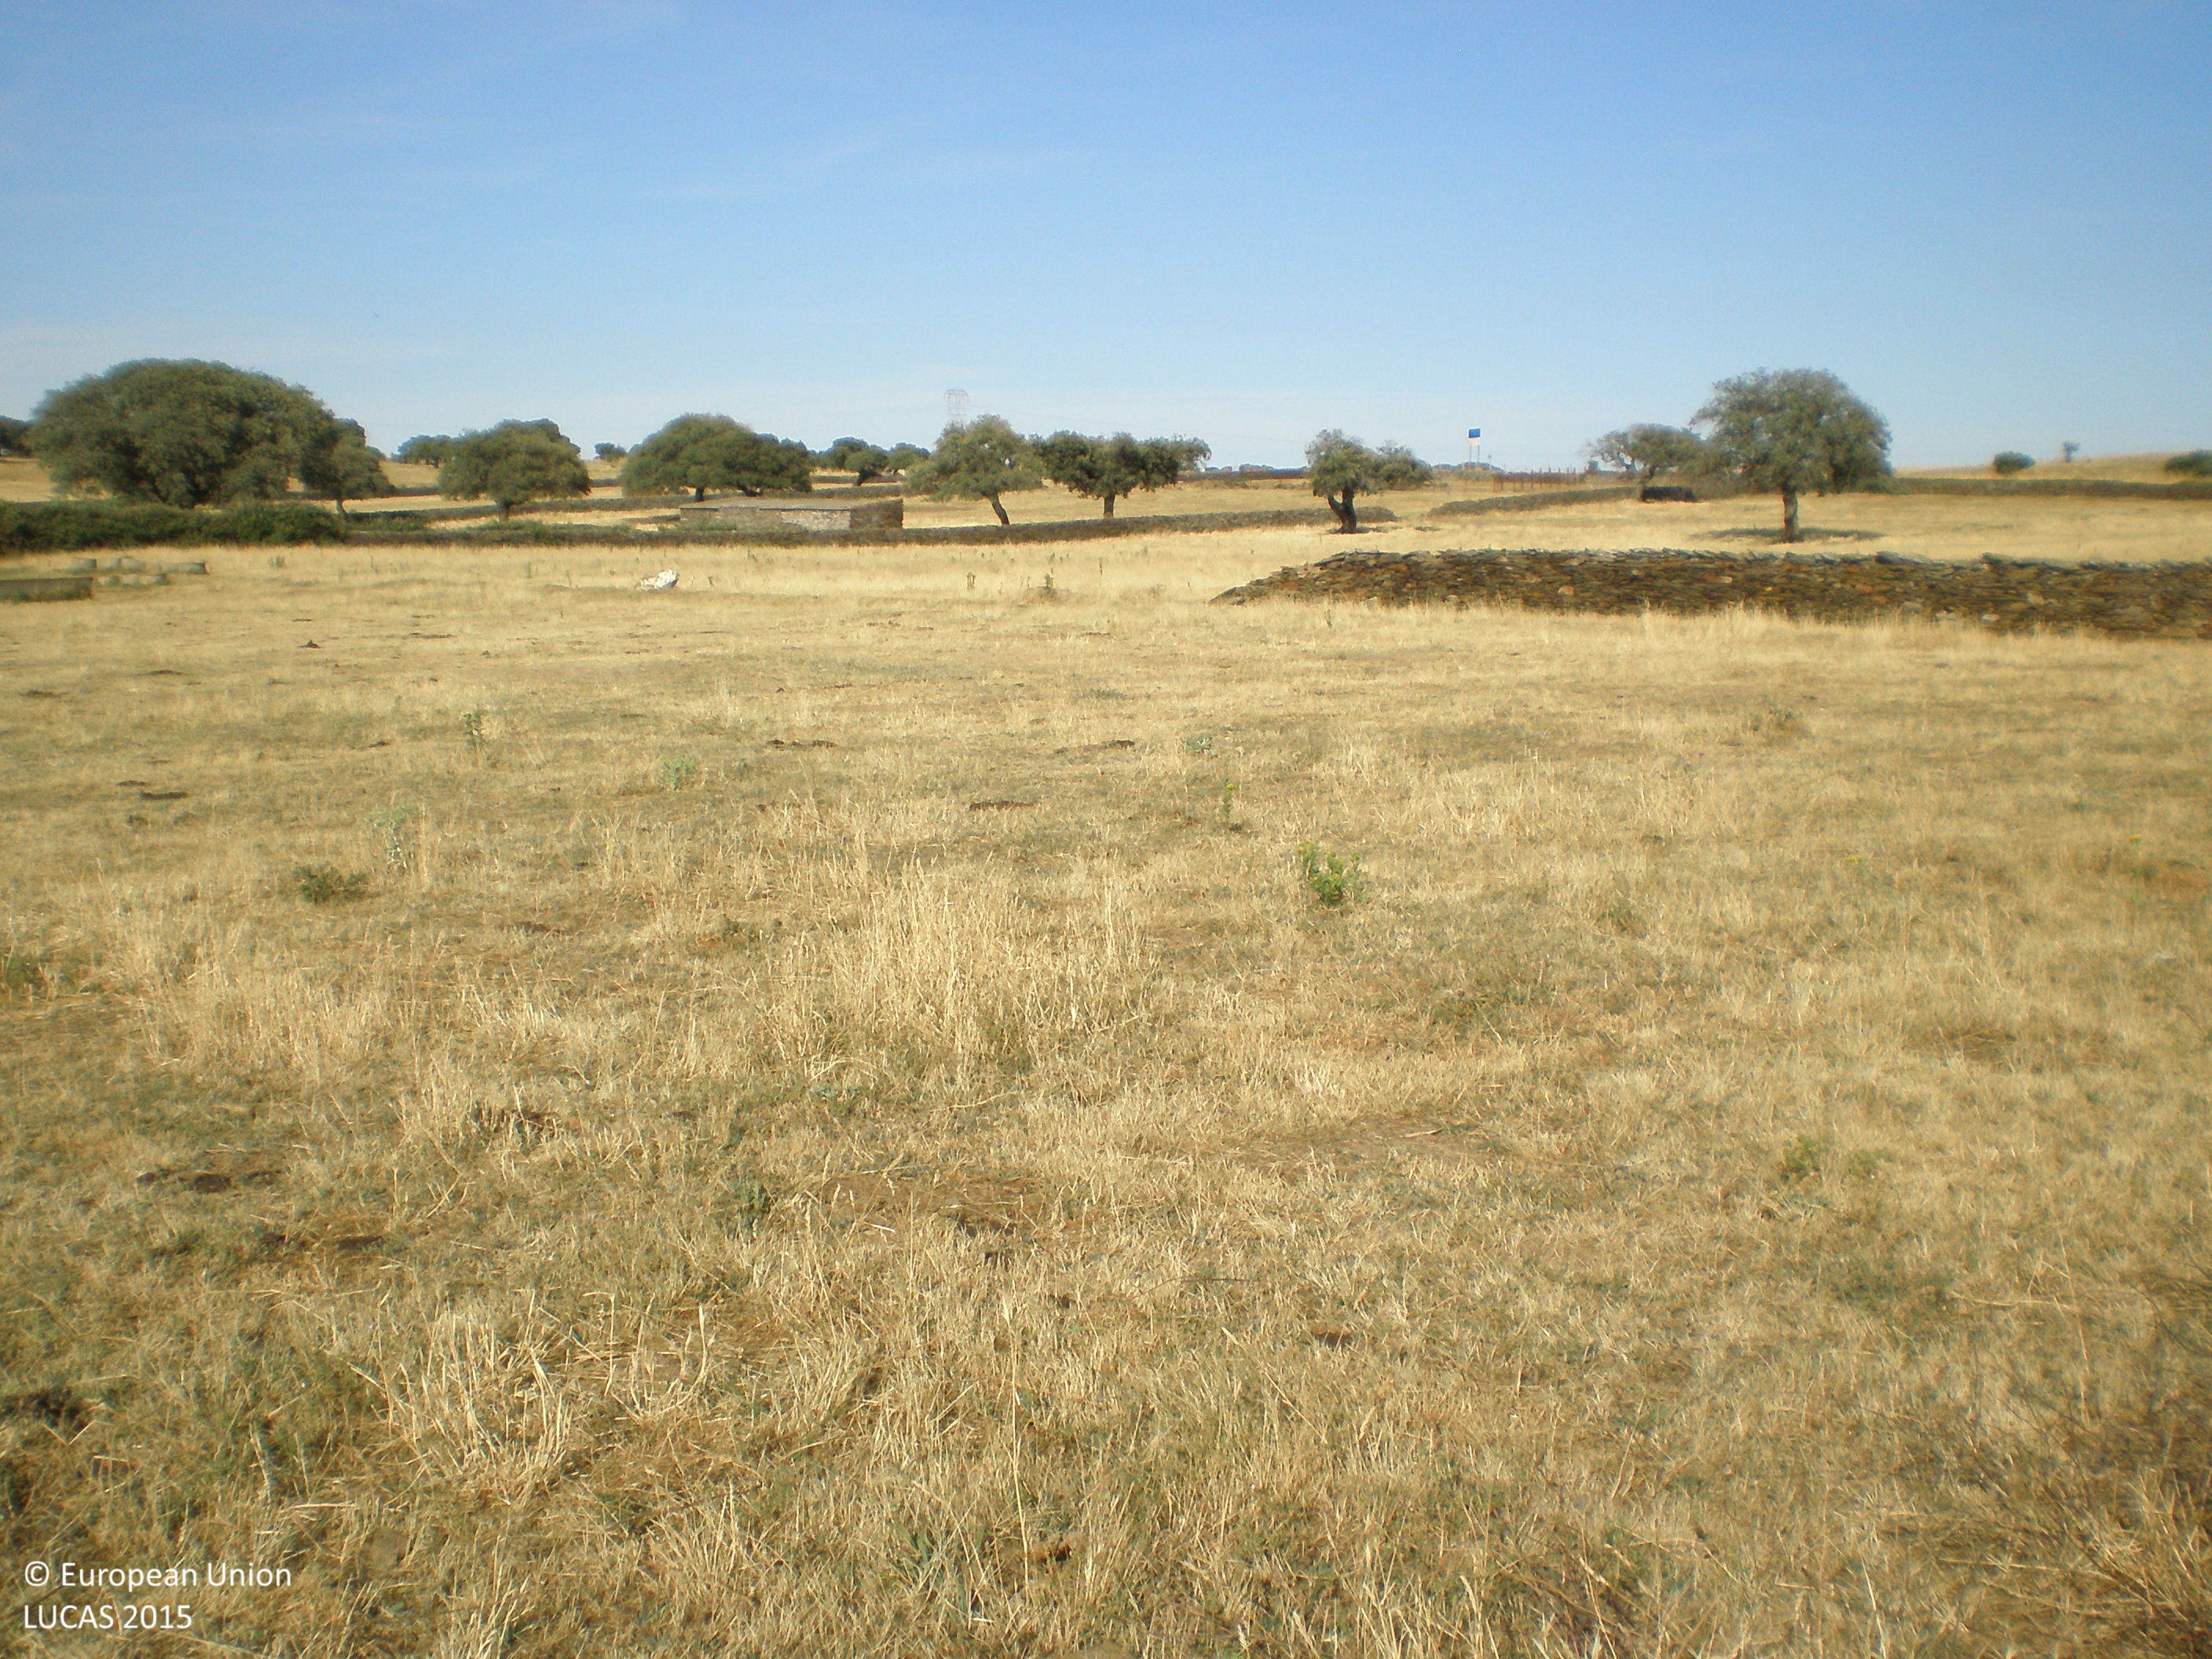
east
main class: Grassland
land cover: Grassland without tree/shrub cover
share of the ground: > 75 %
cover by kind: herbaceous plants 100 %
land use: Agriculture (excluding fallow land and kitchen gardens)
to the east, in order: Grassland without tree/shrub cover; Dry stone walls; Grassland without tree/shrub cover; Dry stone walls; Grassland without tree/shrub cover; Fences; Grassland without tree/shrub cover; Dry stone walls
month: July
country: ES
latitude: 40.5830
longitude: -5.6546
